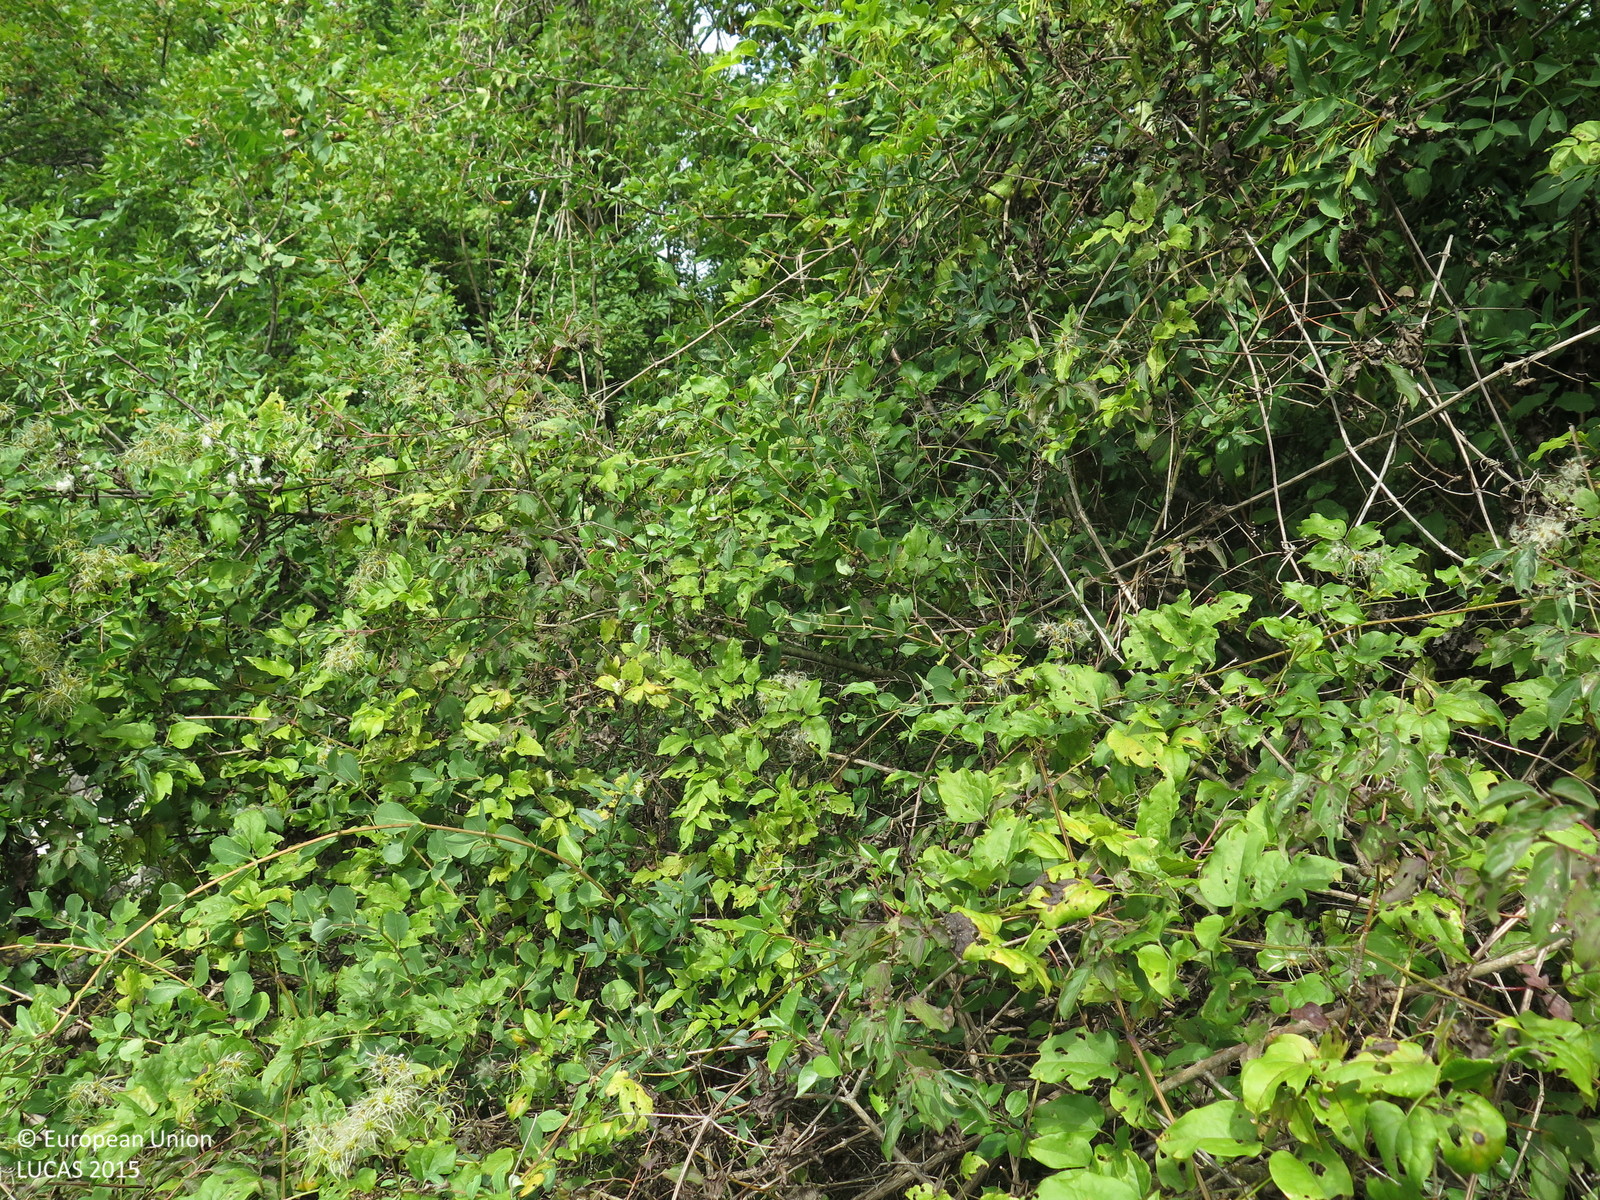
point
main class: Woodland
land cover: Broadleaved woodland
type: thermophilous deciduous forest
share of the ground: > 75 %
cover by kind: broadleaved forest trees 90 %, shrubs 5 %, herbaceous plants 5 %
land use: Semi-natural and natural areas not in use
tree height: > 5 m
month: August
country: HR
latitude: 45.1498
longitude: 14.6371
